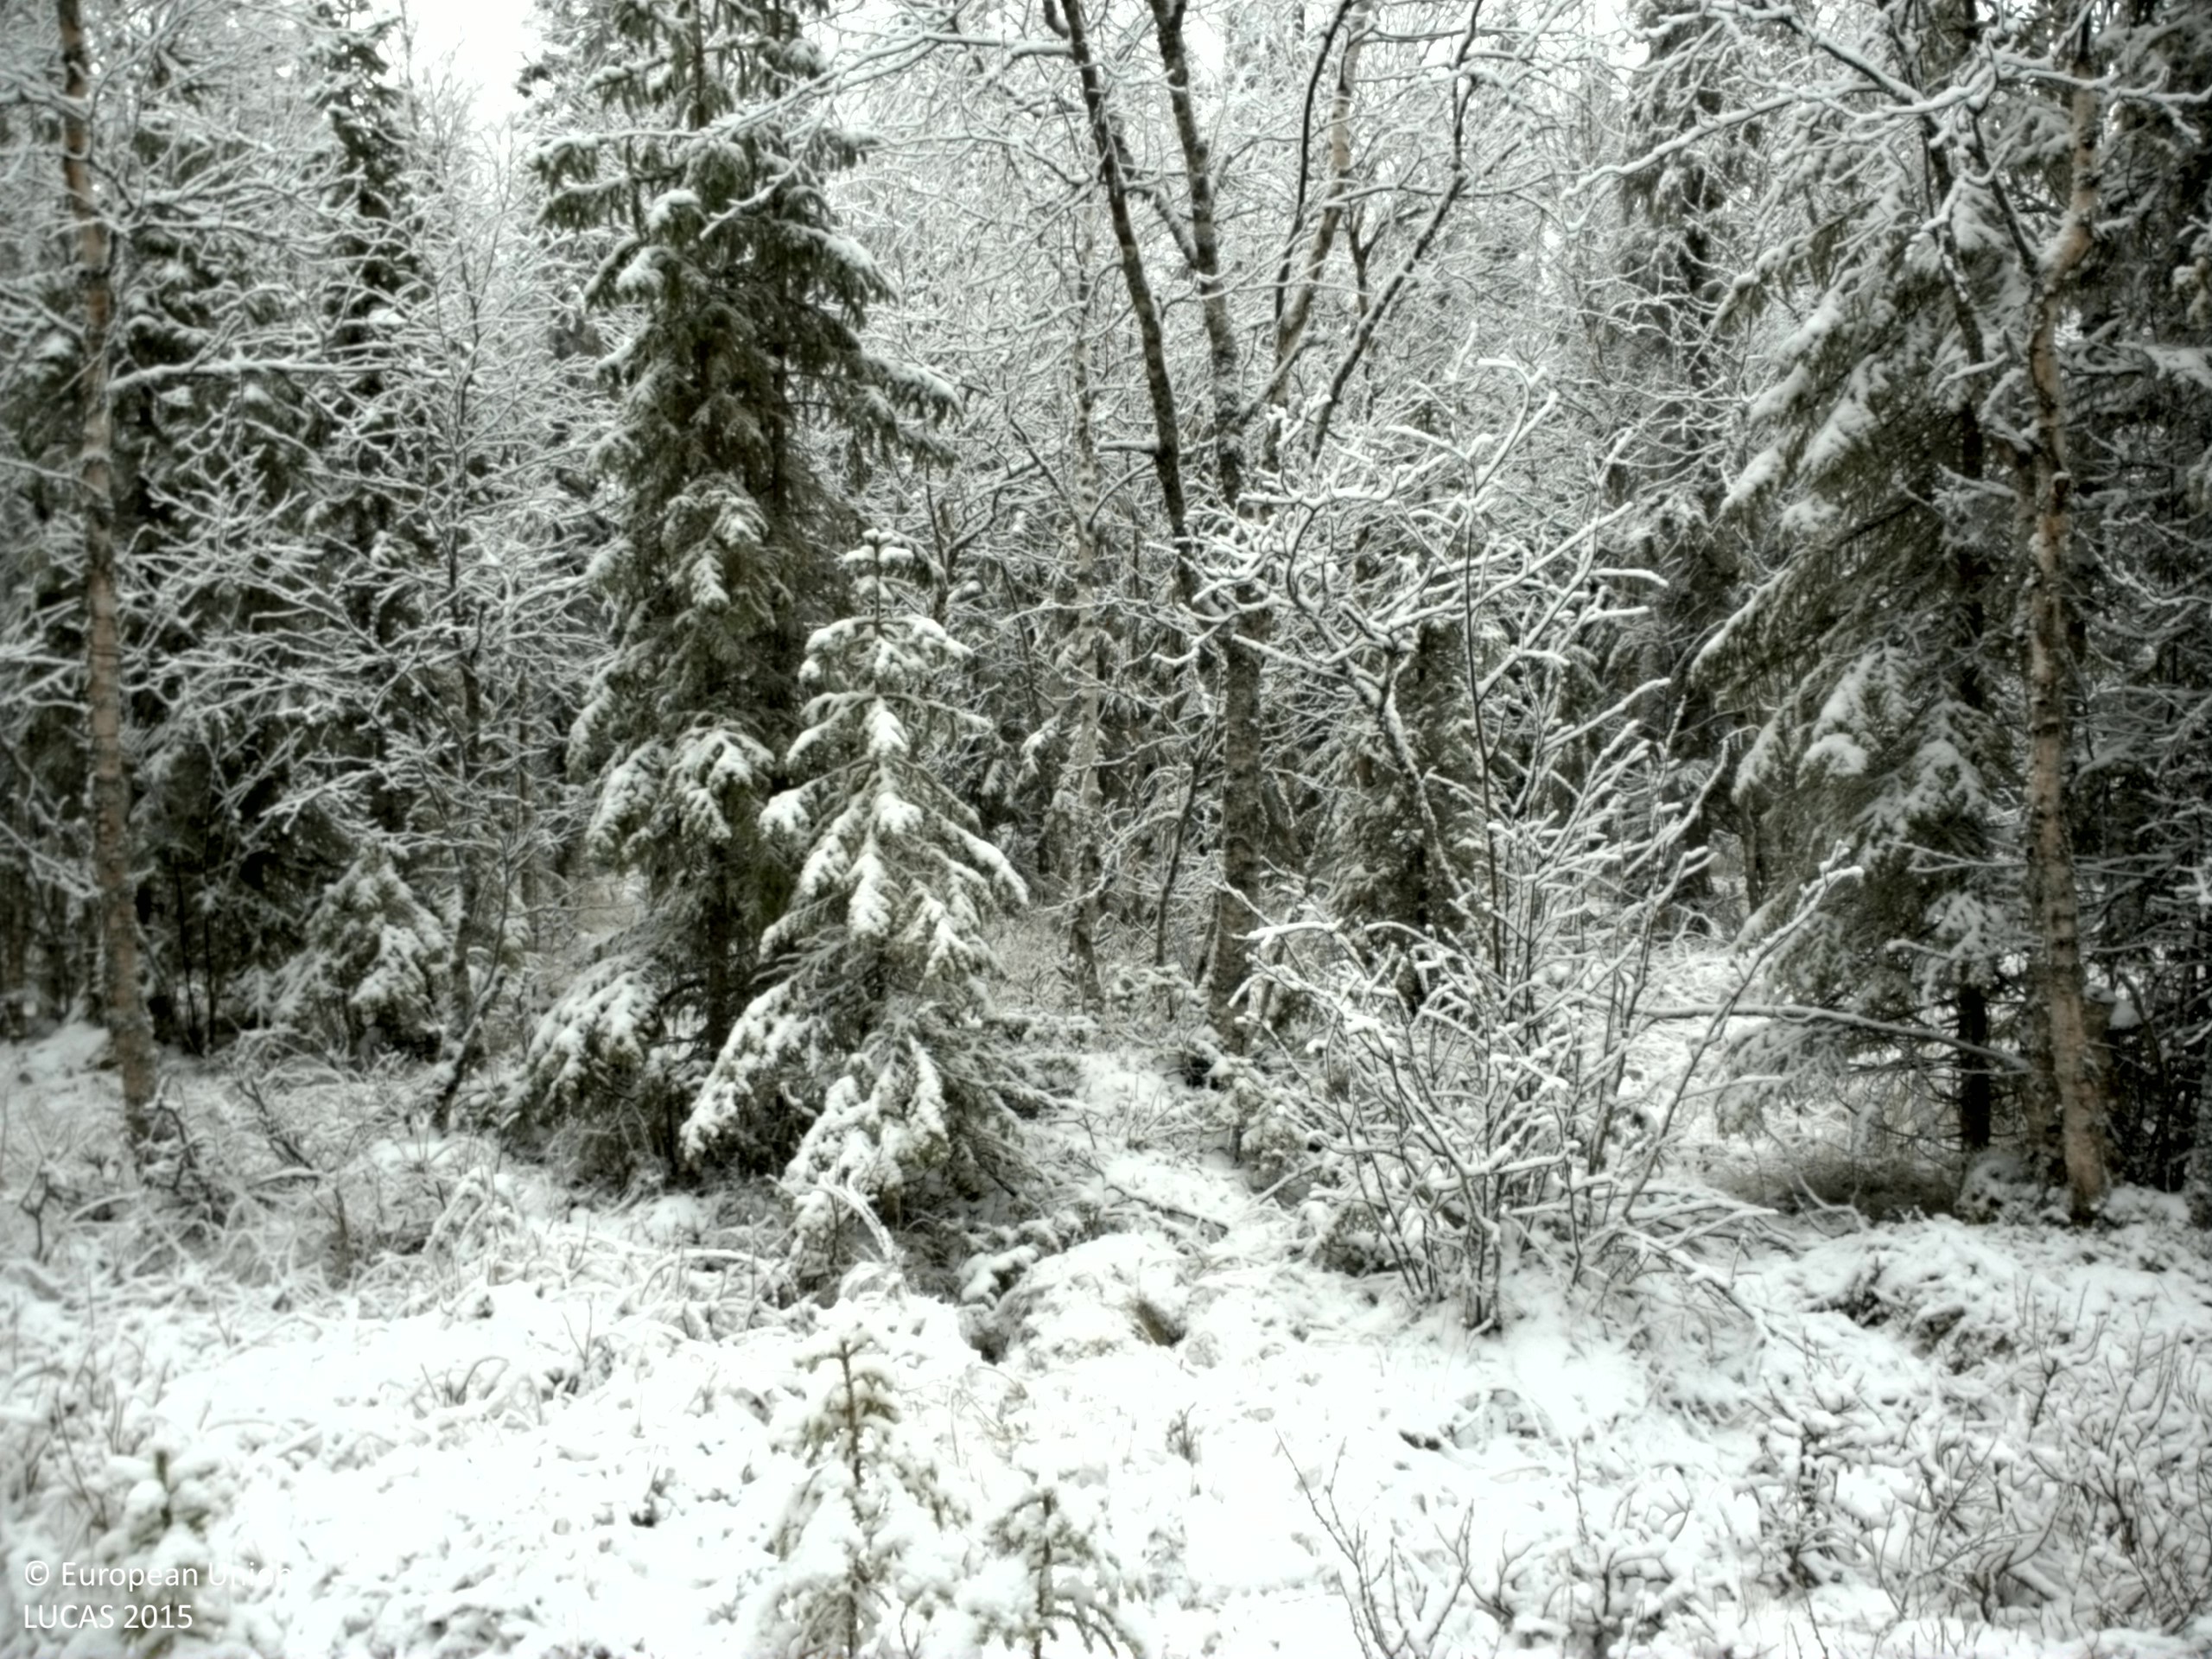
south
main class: Woodland
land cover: Spruce dominated mixed woodland
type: exotic forest
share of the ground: 50 - 75 %
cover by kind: shrubs 35 %, coniferous forest trees 30 %, broadleaved forest trees 20 %, lichens and mosses 15 %
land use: Forestry
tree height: > 5 m
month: November
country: SE
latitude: 63.7292
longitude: 15.3407
